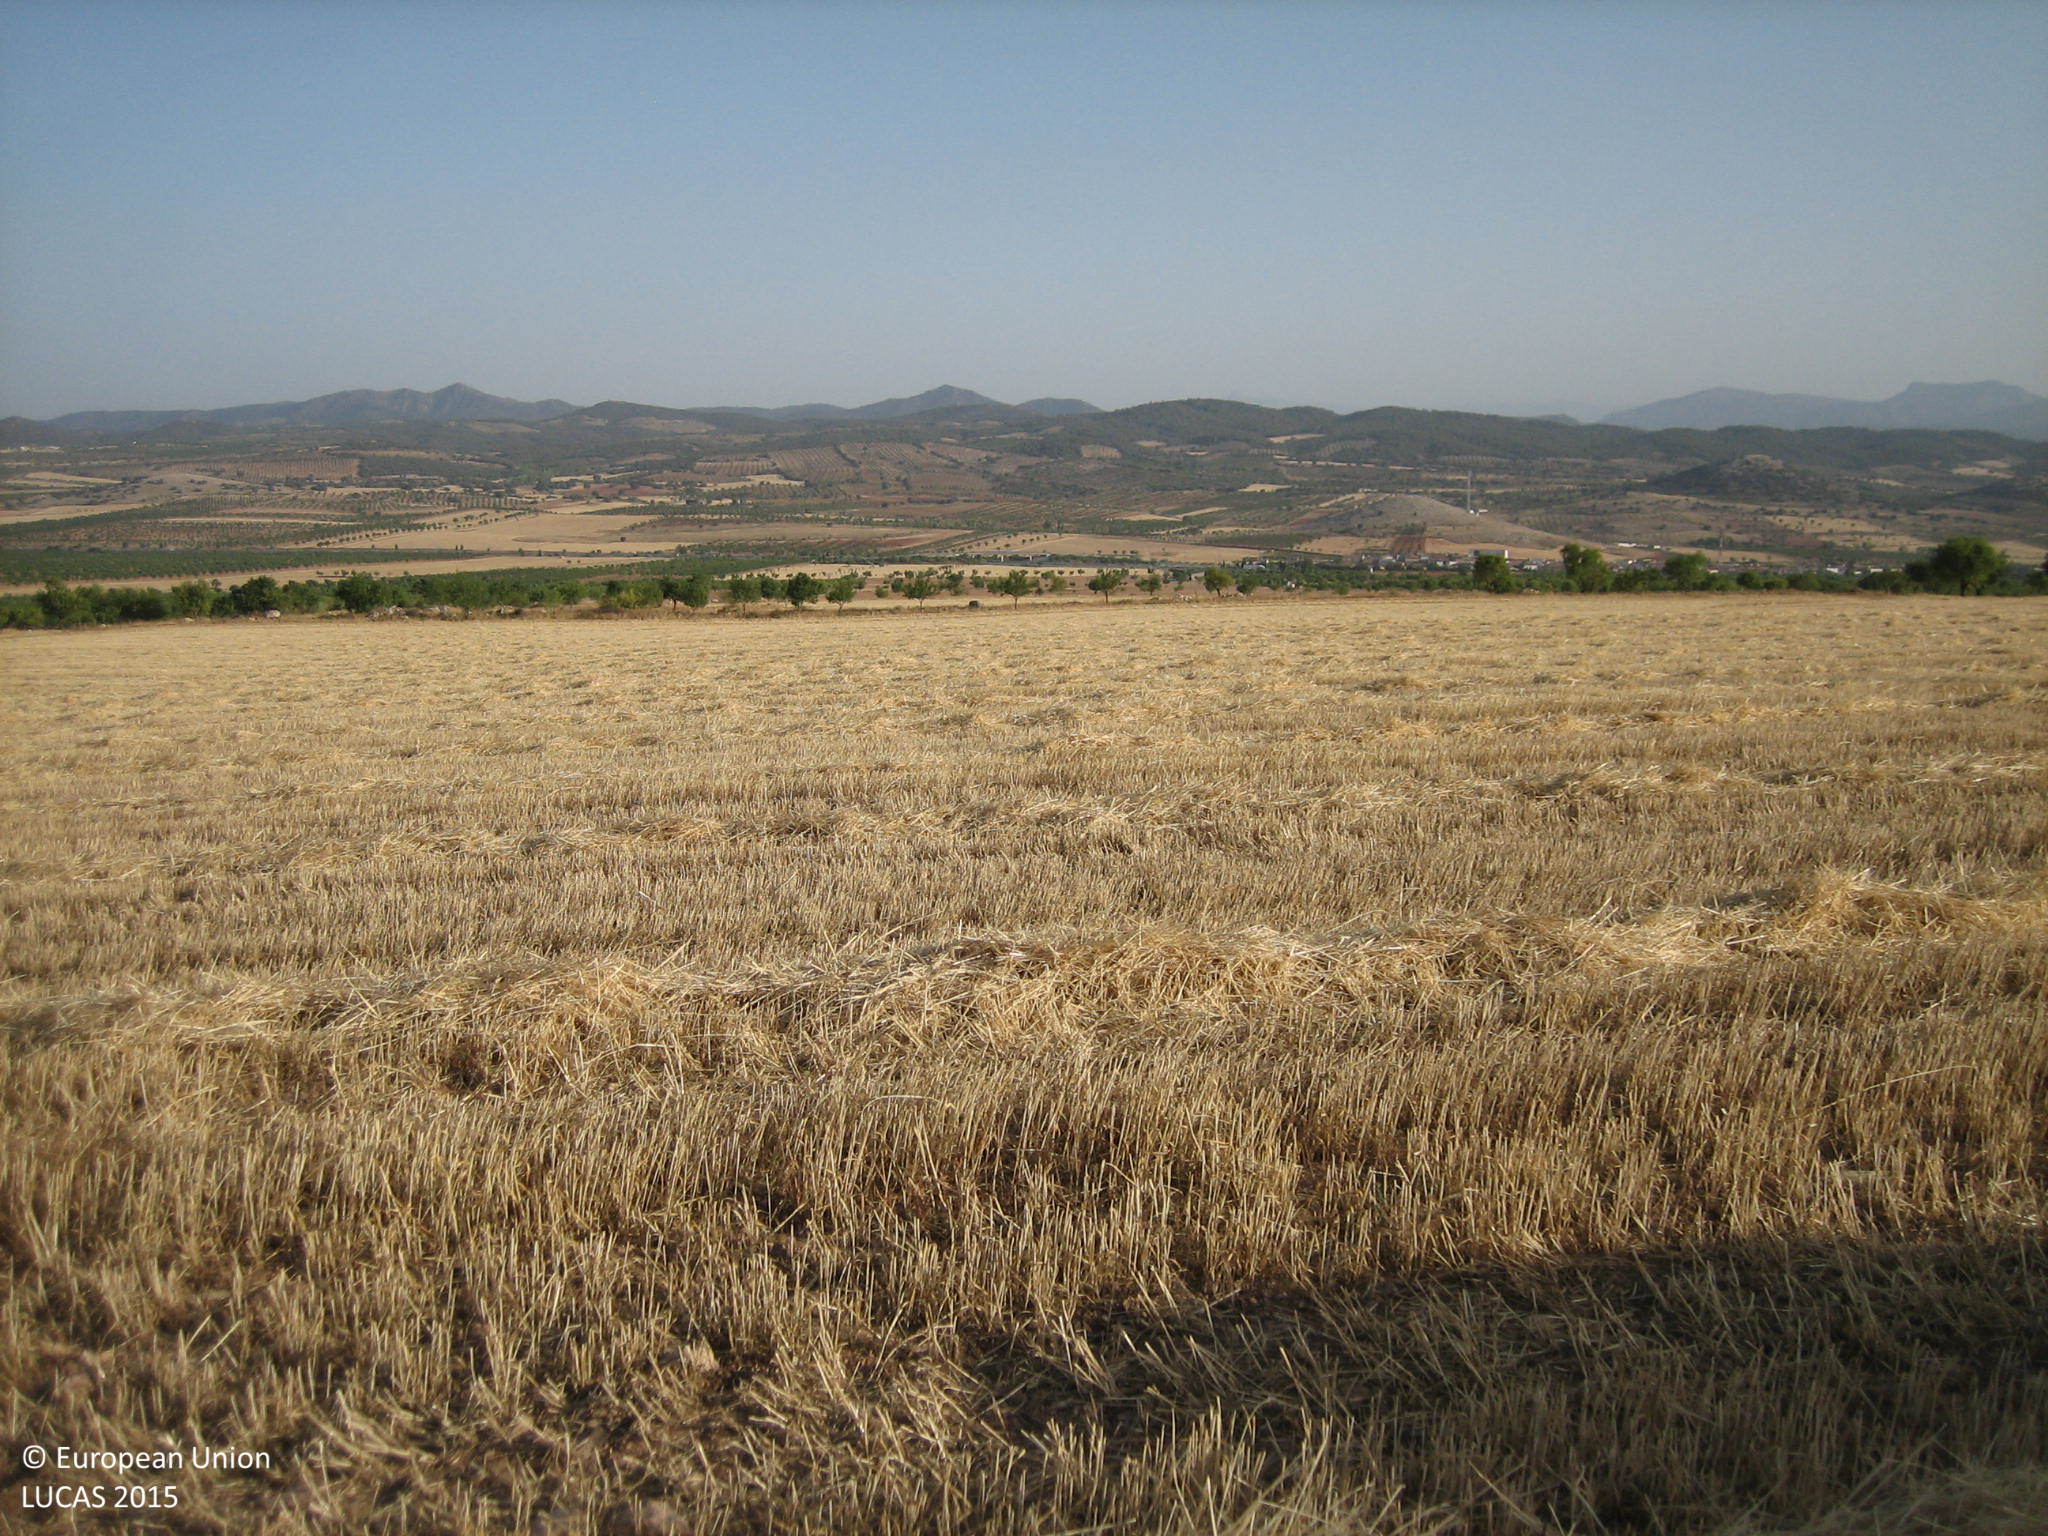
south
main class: Cropland
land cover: Barley
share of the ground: < 10 %
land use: Agriculture (excluding fallow land and kitchen gardens)
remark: Harvested field
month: July
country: ES
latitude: 37.6118
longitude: -2.3907
